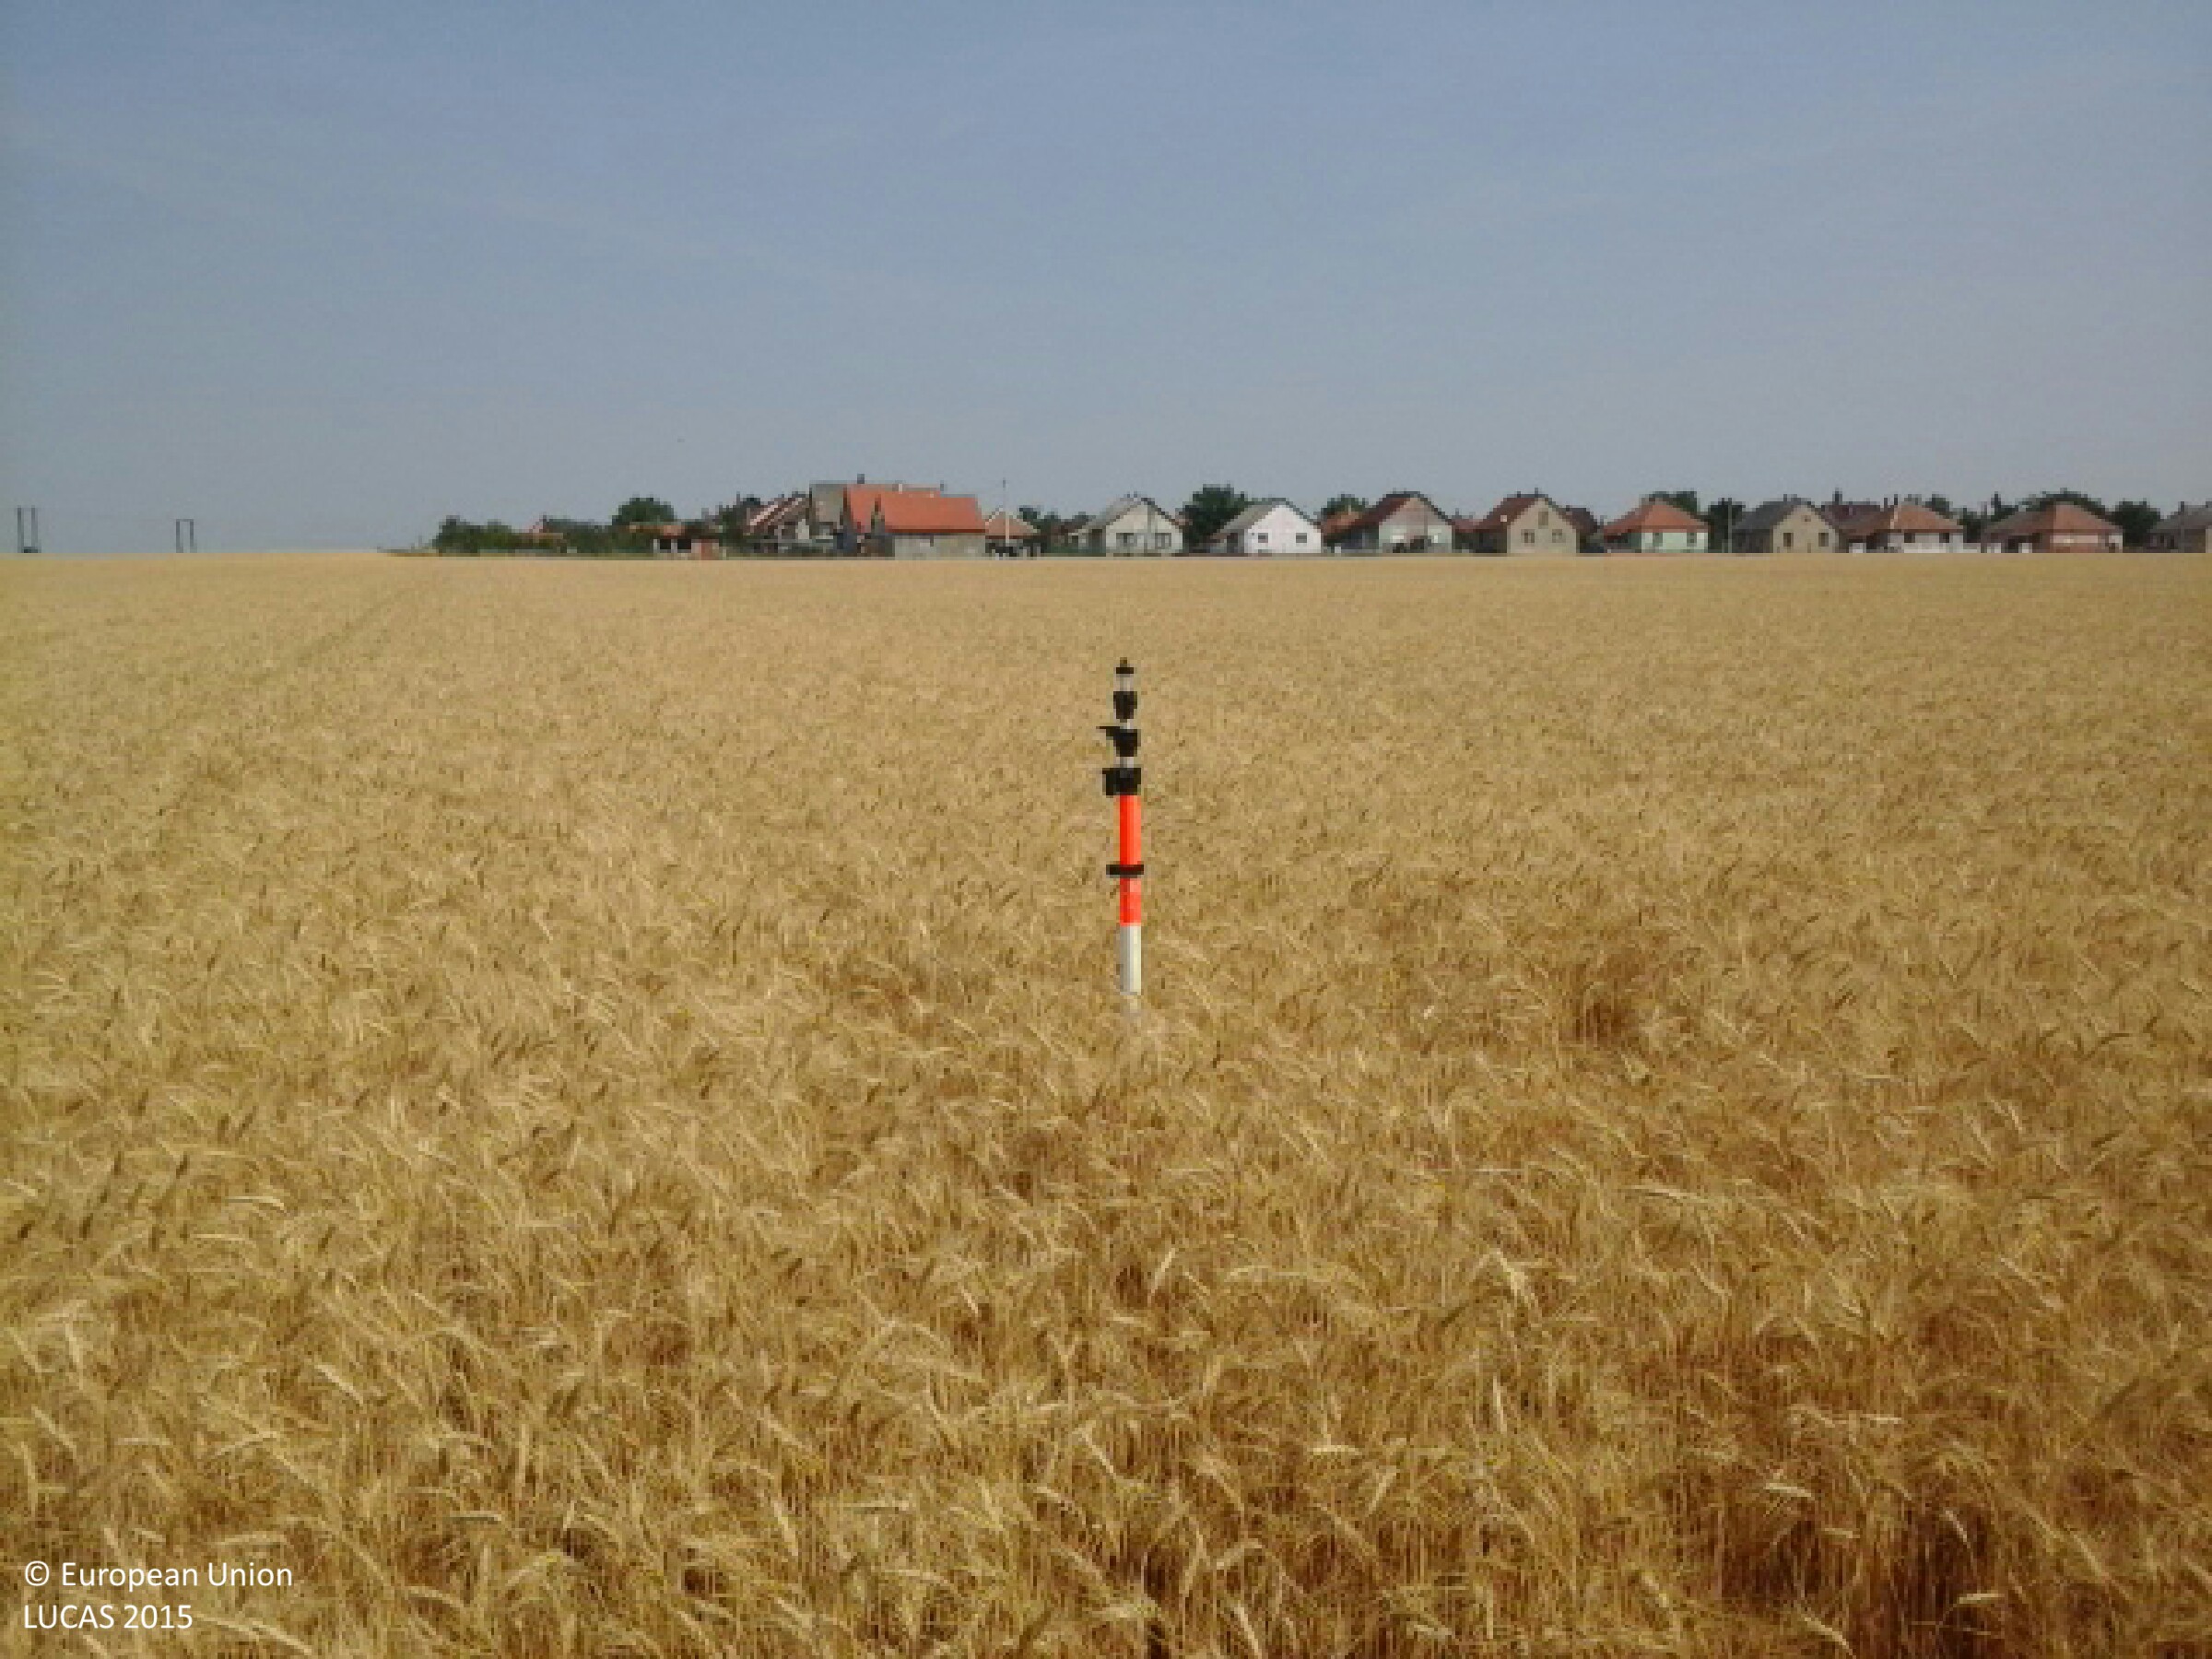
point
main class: Cropland
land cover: Triticale
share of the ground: > 75 %
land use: Agriculture (excluding fallow land and kitchen gardens)
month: July
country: HU
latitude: 48.0295
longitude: 21.0493
